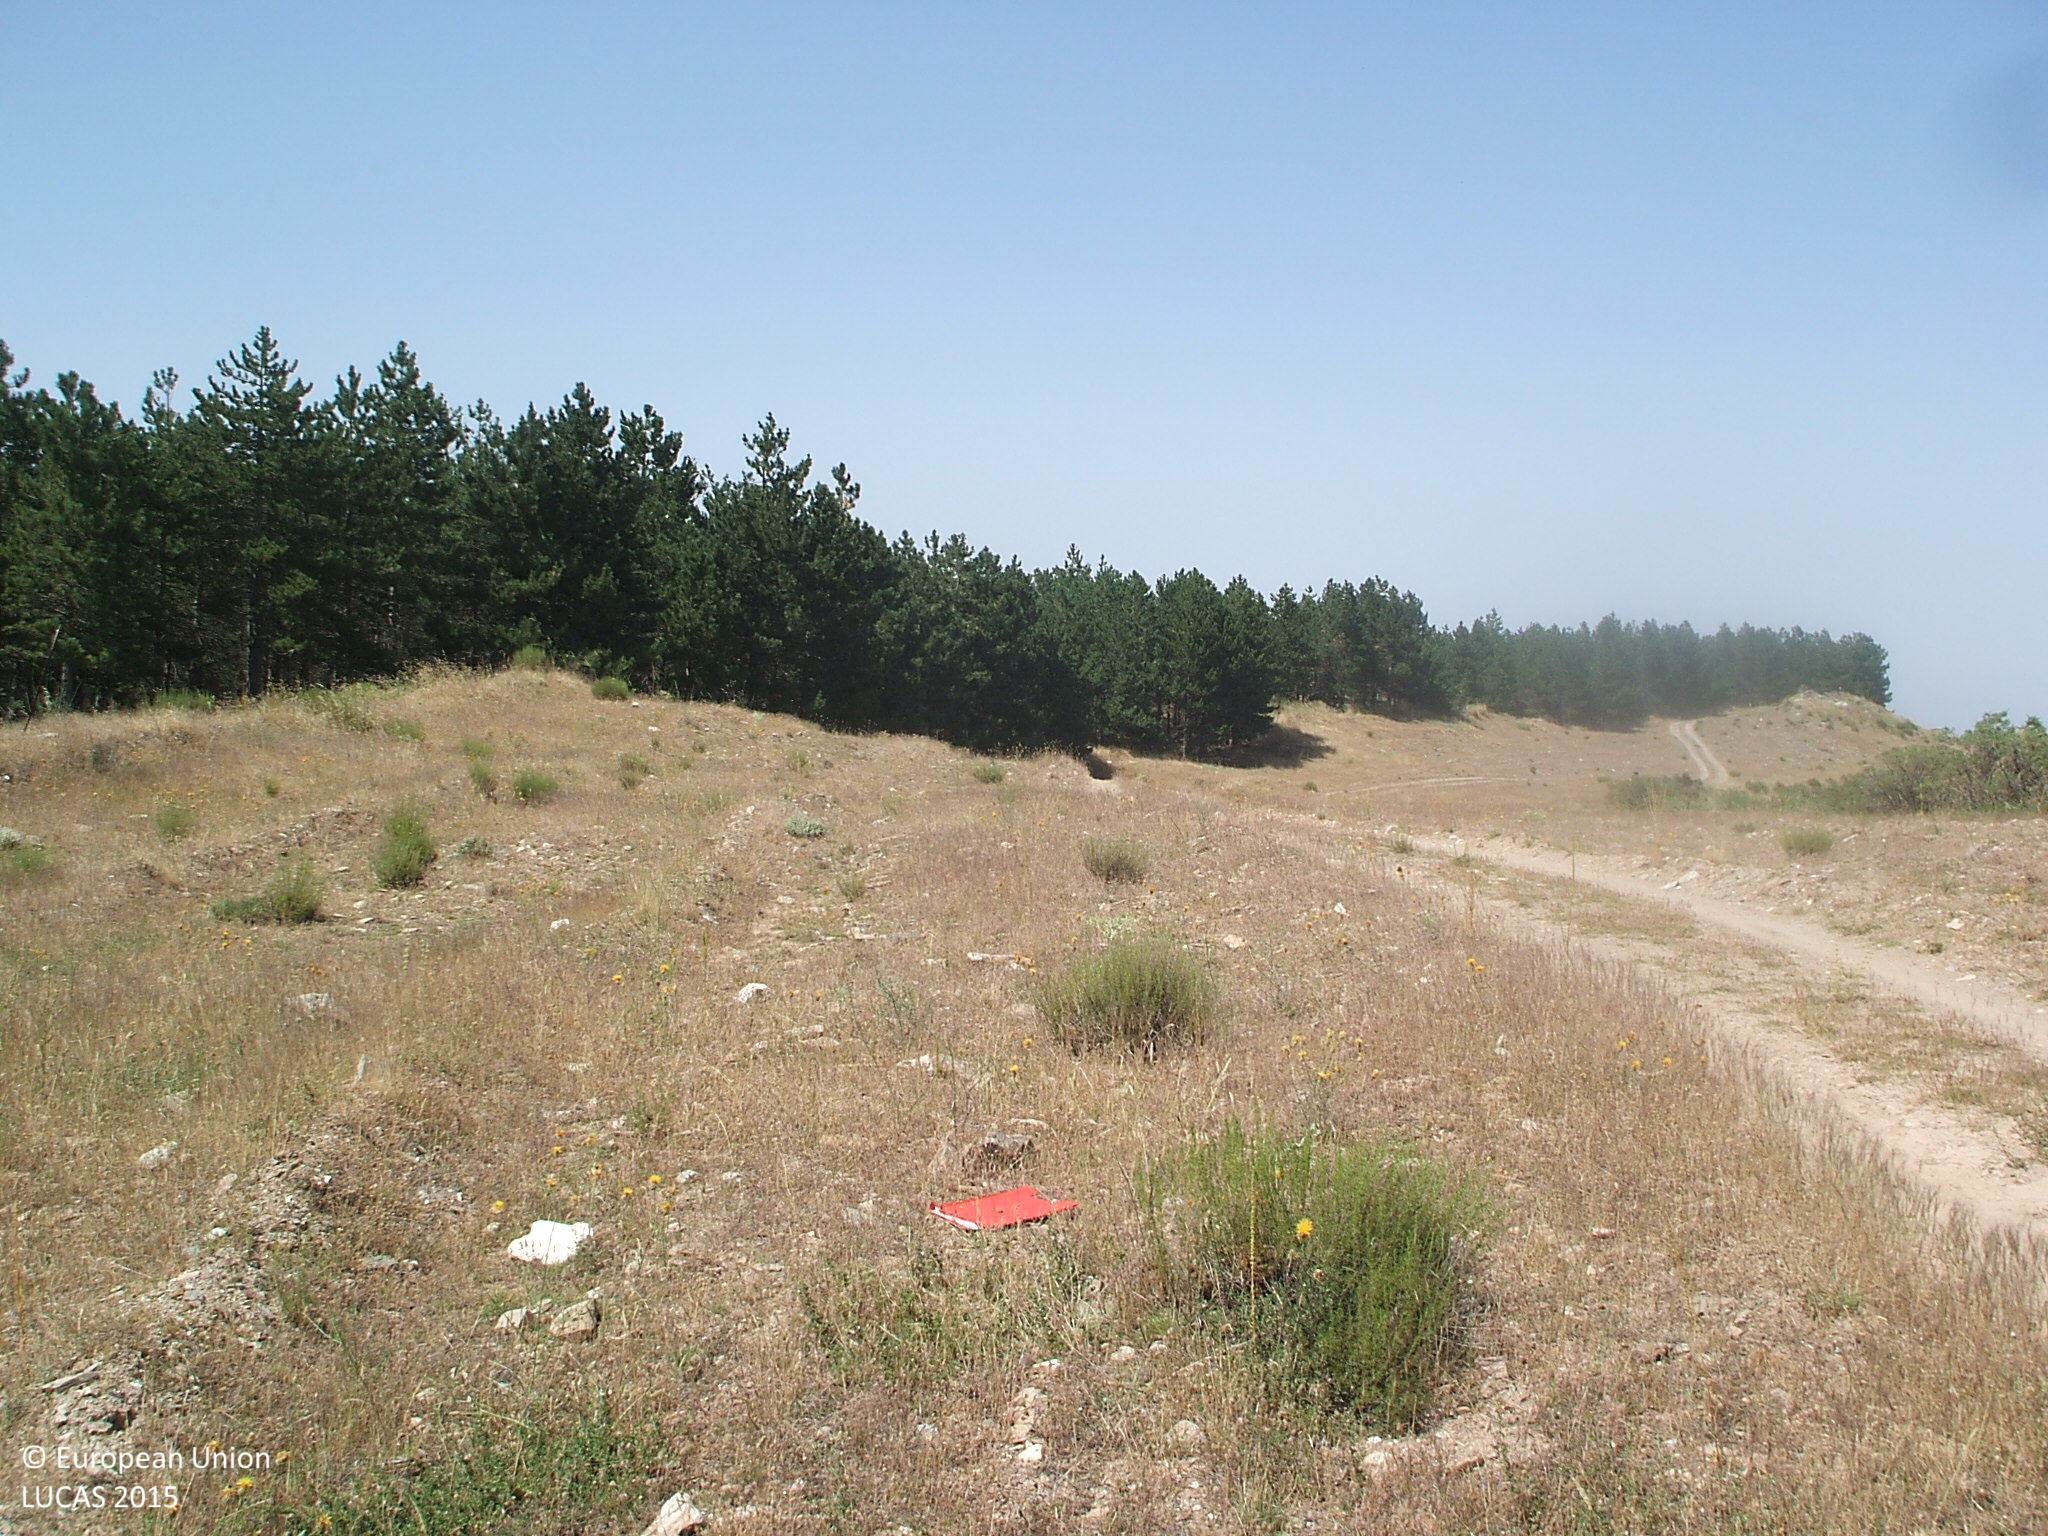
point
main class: Grassland
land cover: Grassland without tree/shrub cover
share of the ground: > 75 %
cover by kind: herbaceous plants 75 %, unconsolidated bare surface 15 %, shrubs 5 %, consolidated bare surface 5 %
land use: Forestry
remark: Fire break
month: July
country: ES
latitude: 37.2480
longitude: -2.3705
